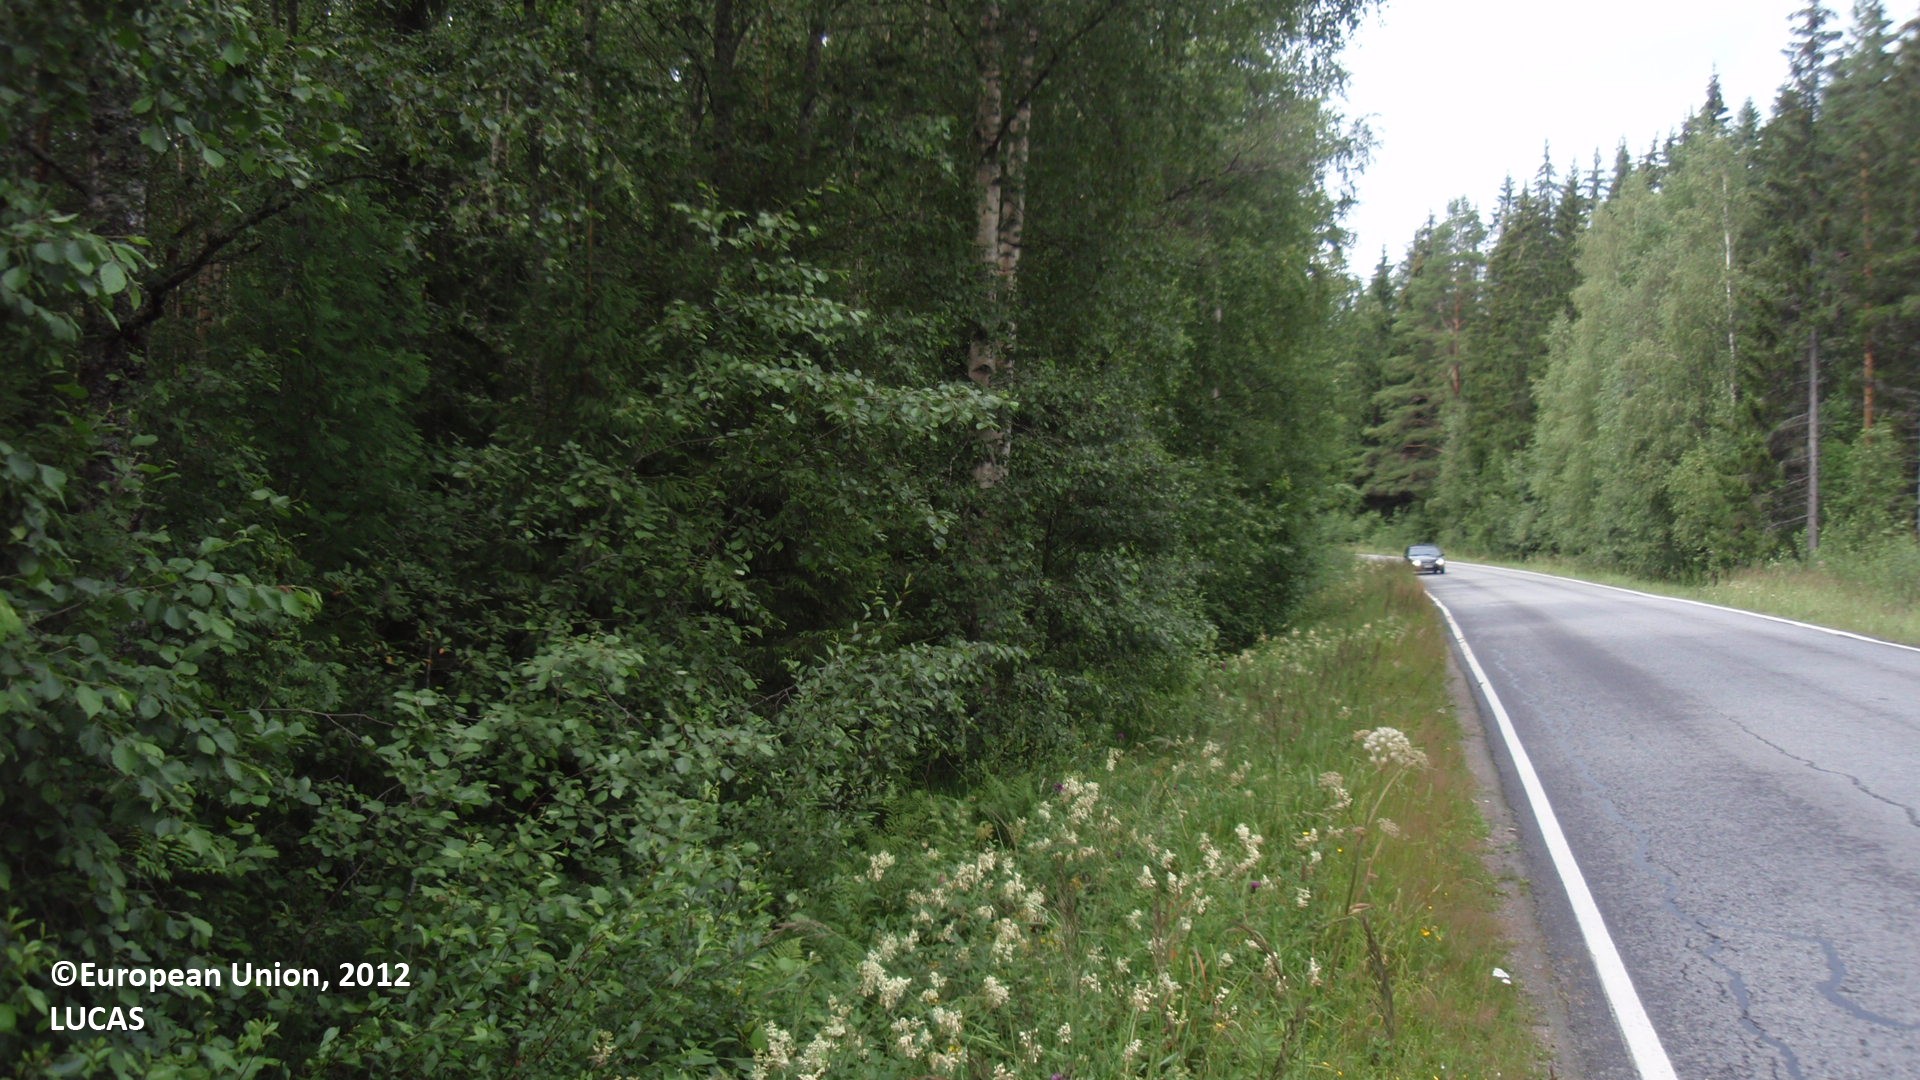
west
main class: Grassland
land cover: Grassland with sparse tree/shrub cover
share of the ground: > 75 %
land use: Road transport
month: July
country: FI
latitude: 61.5156
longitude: 27.2166
